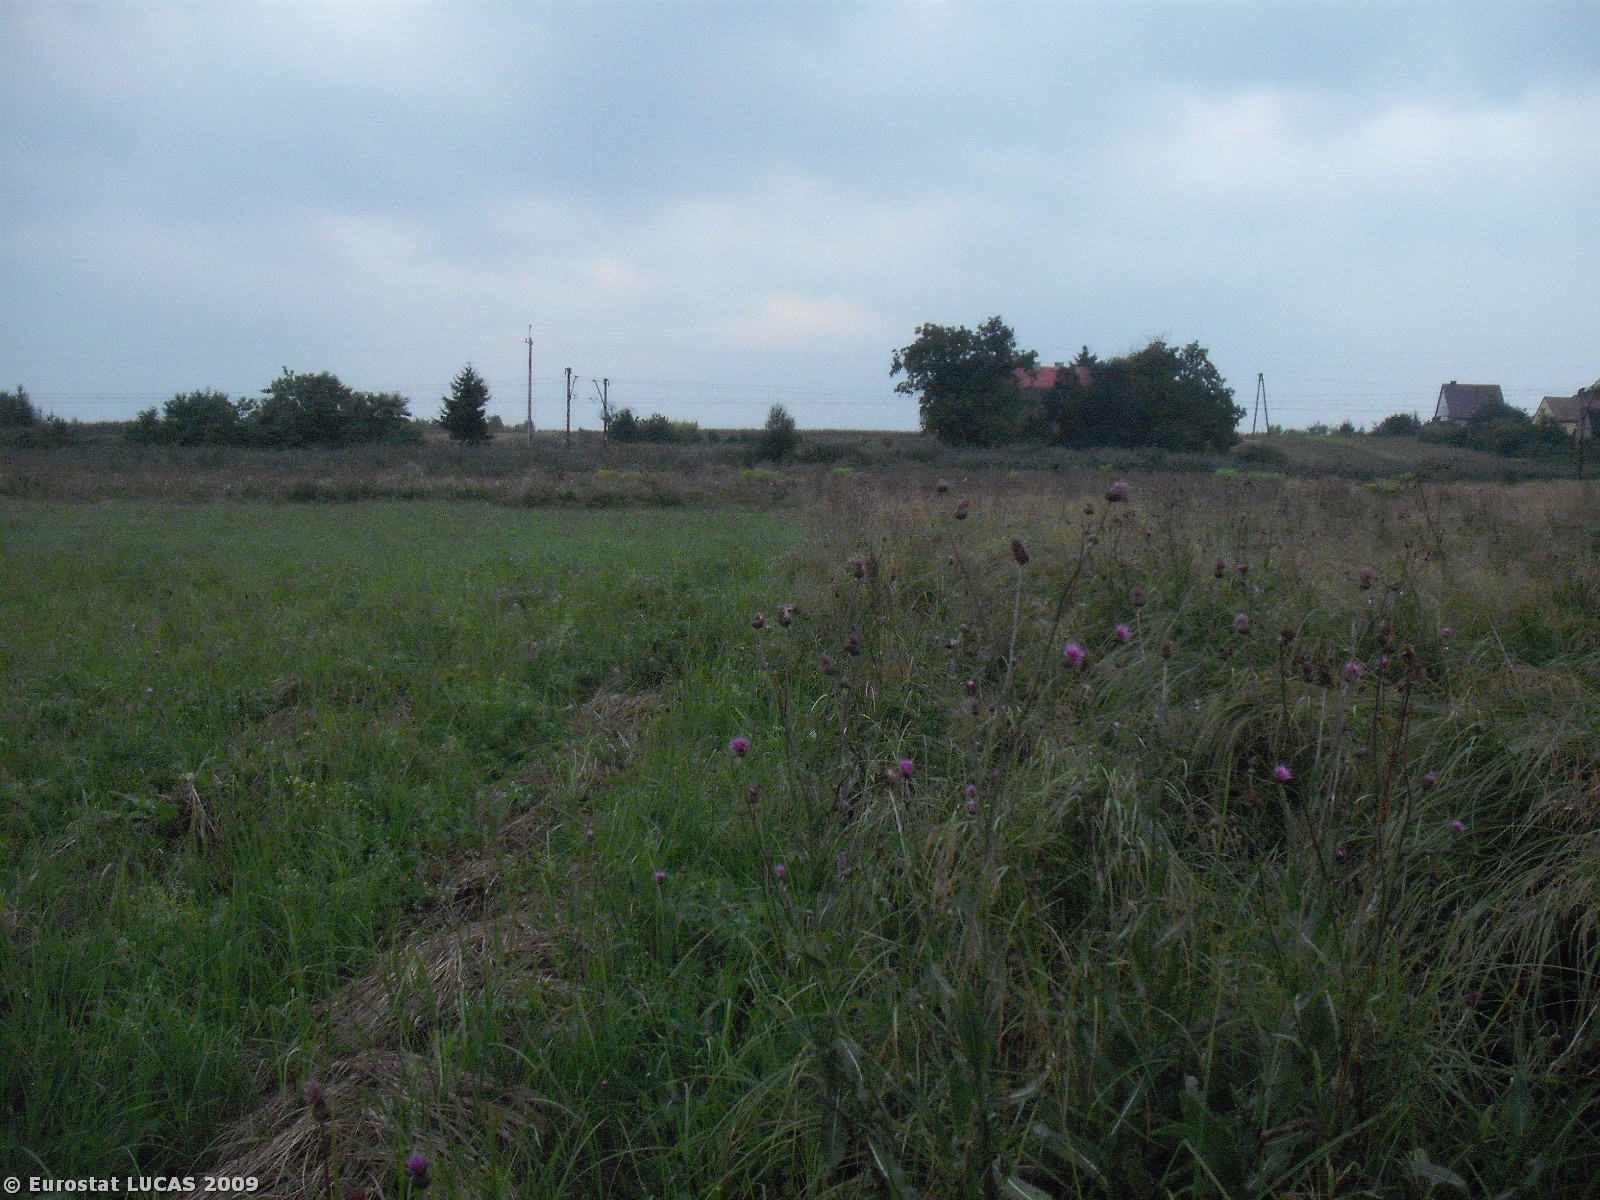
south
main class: Grassland
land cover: Grassland without tree/shrub cover
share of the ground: > 75 %
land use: Agriculture (excluding fallow land and kitchen gardens)
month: August
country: PL
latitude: 50.0799
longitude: 22.4599
